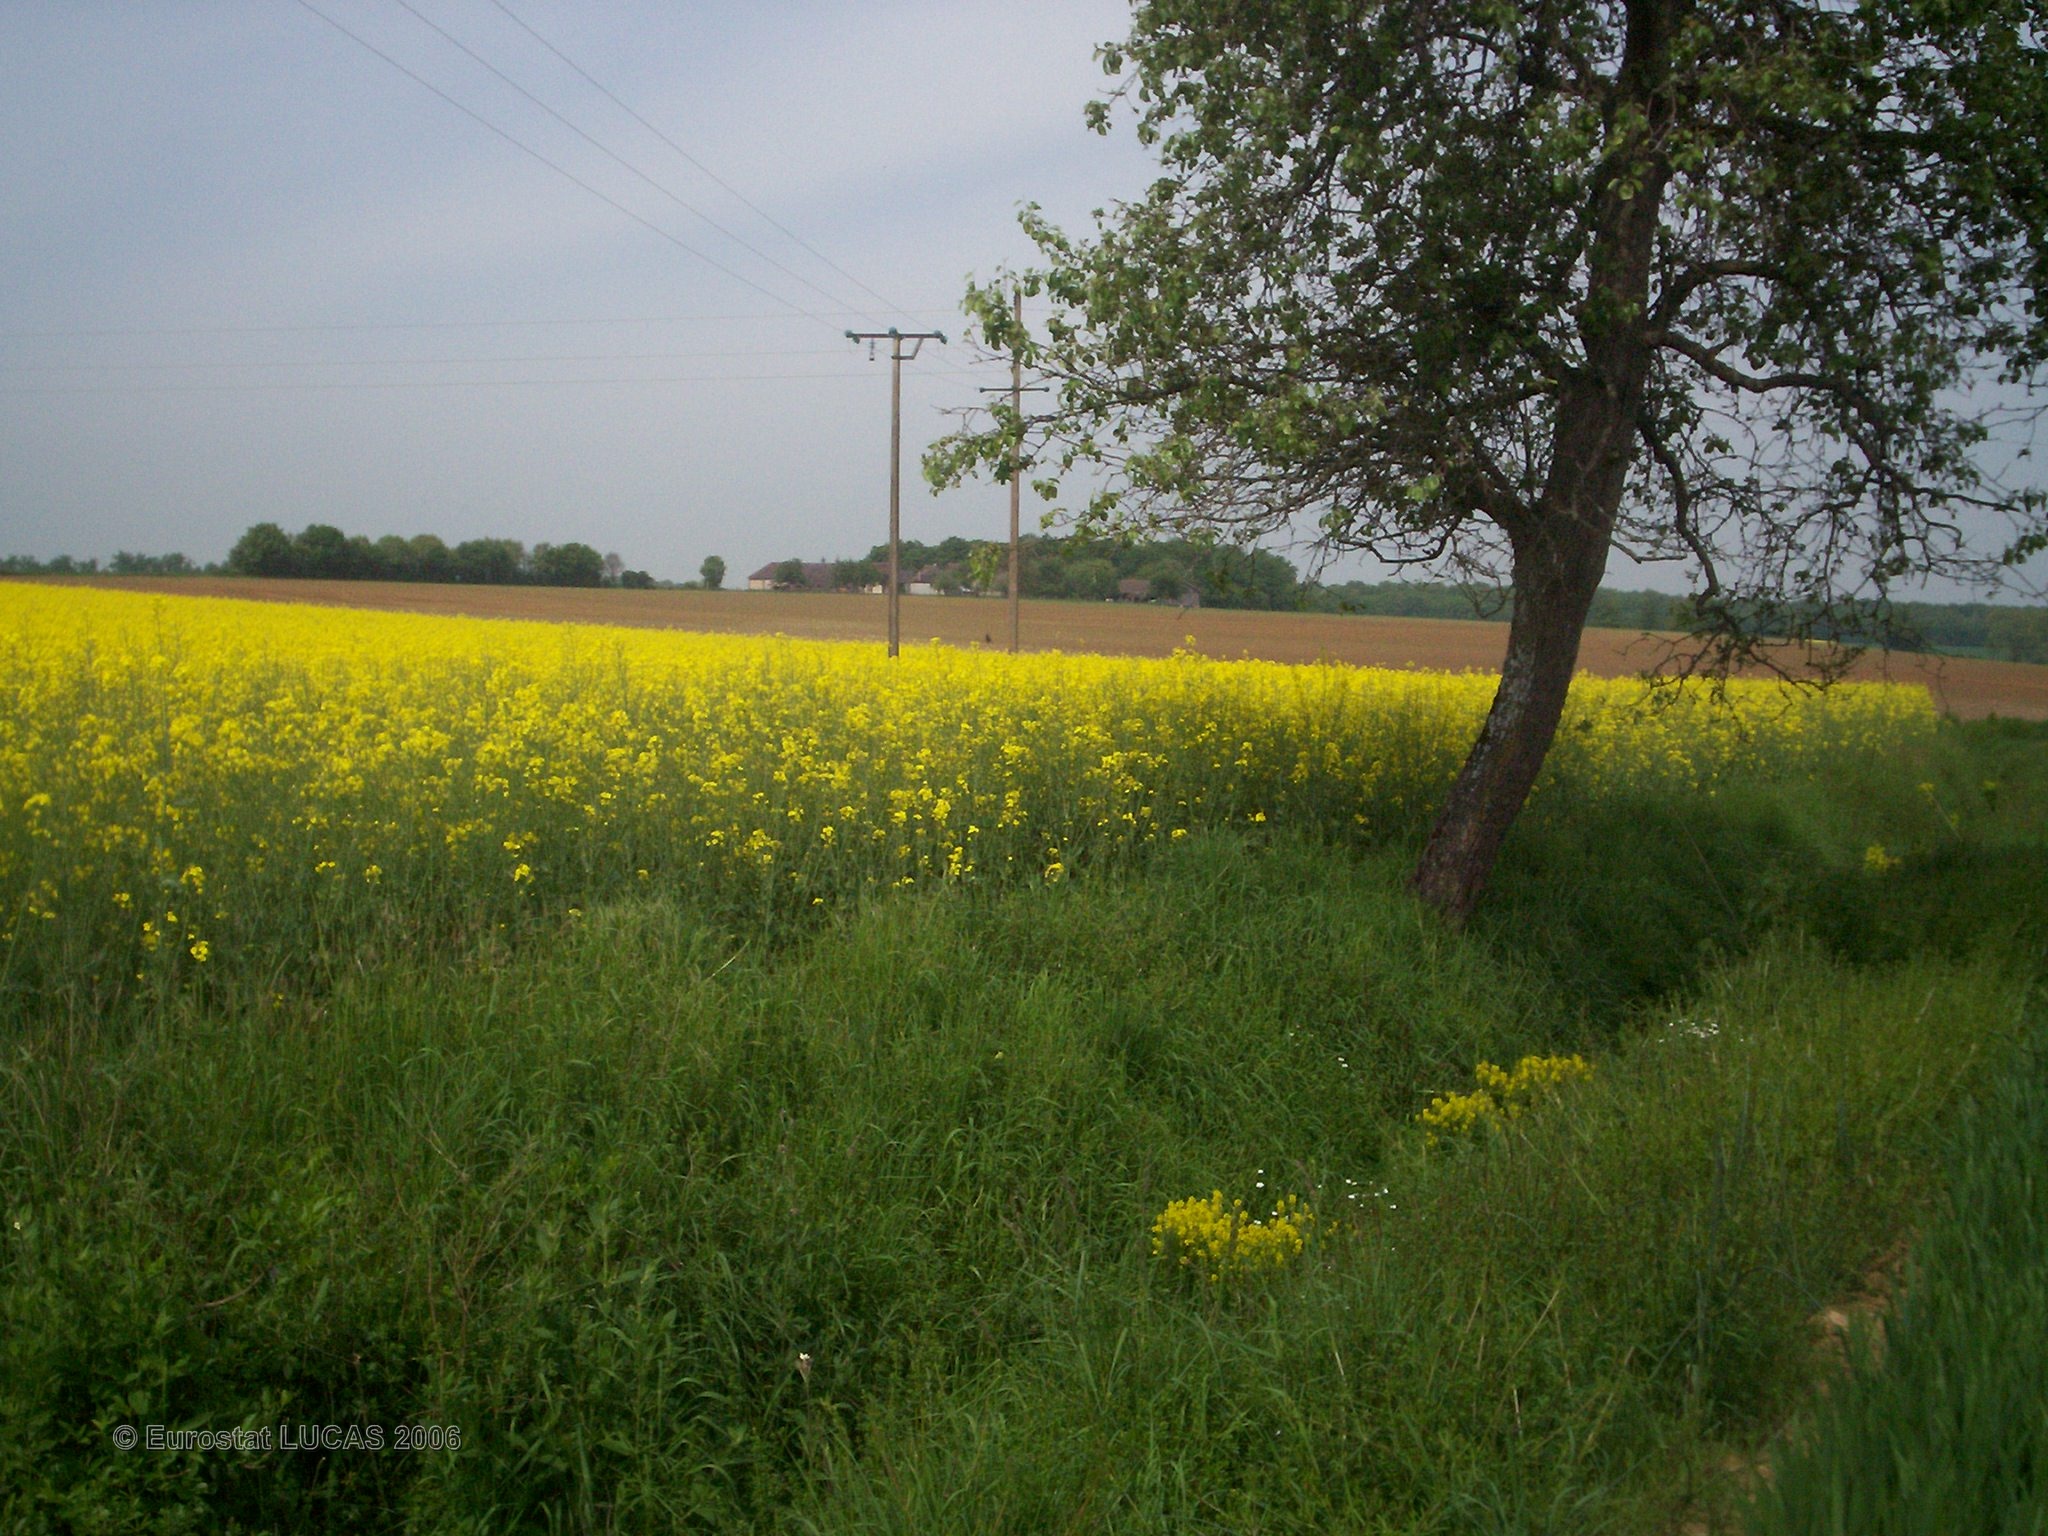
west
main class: Cropland
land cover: Common wheat
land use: Agriculture (excluding fallow land and kitchen gardens)
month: May
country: FR
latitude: 47.7279
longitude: 2.9671
